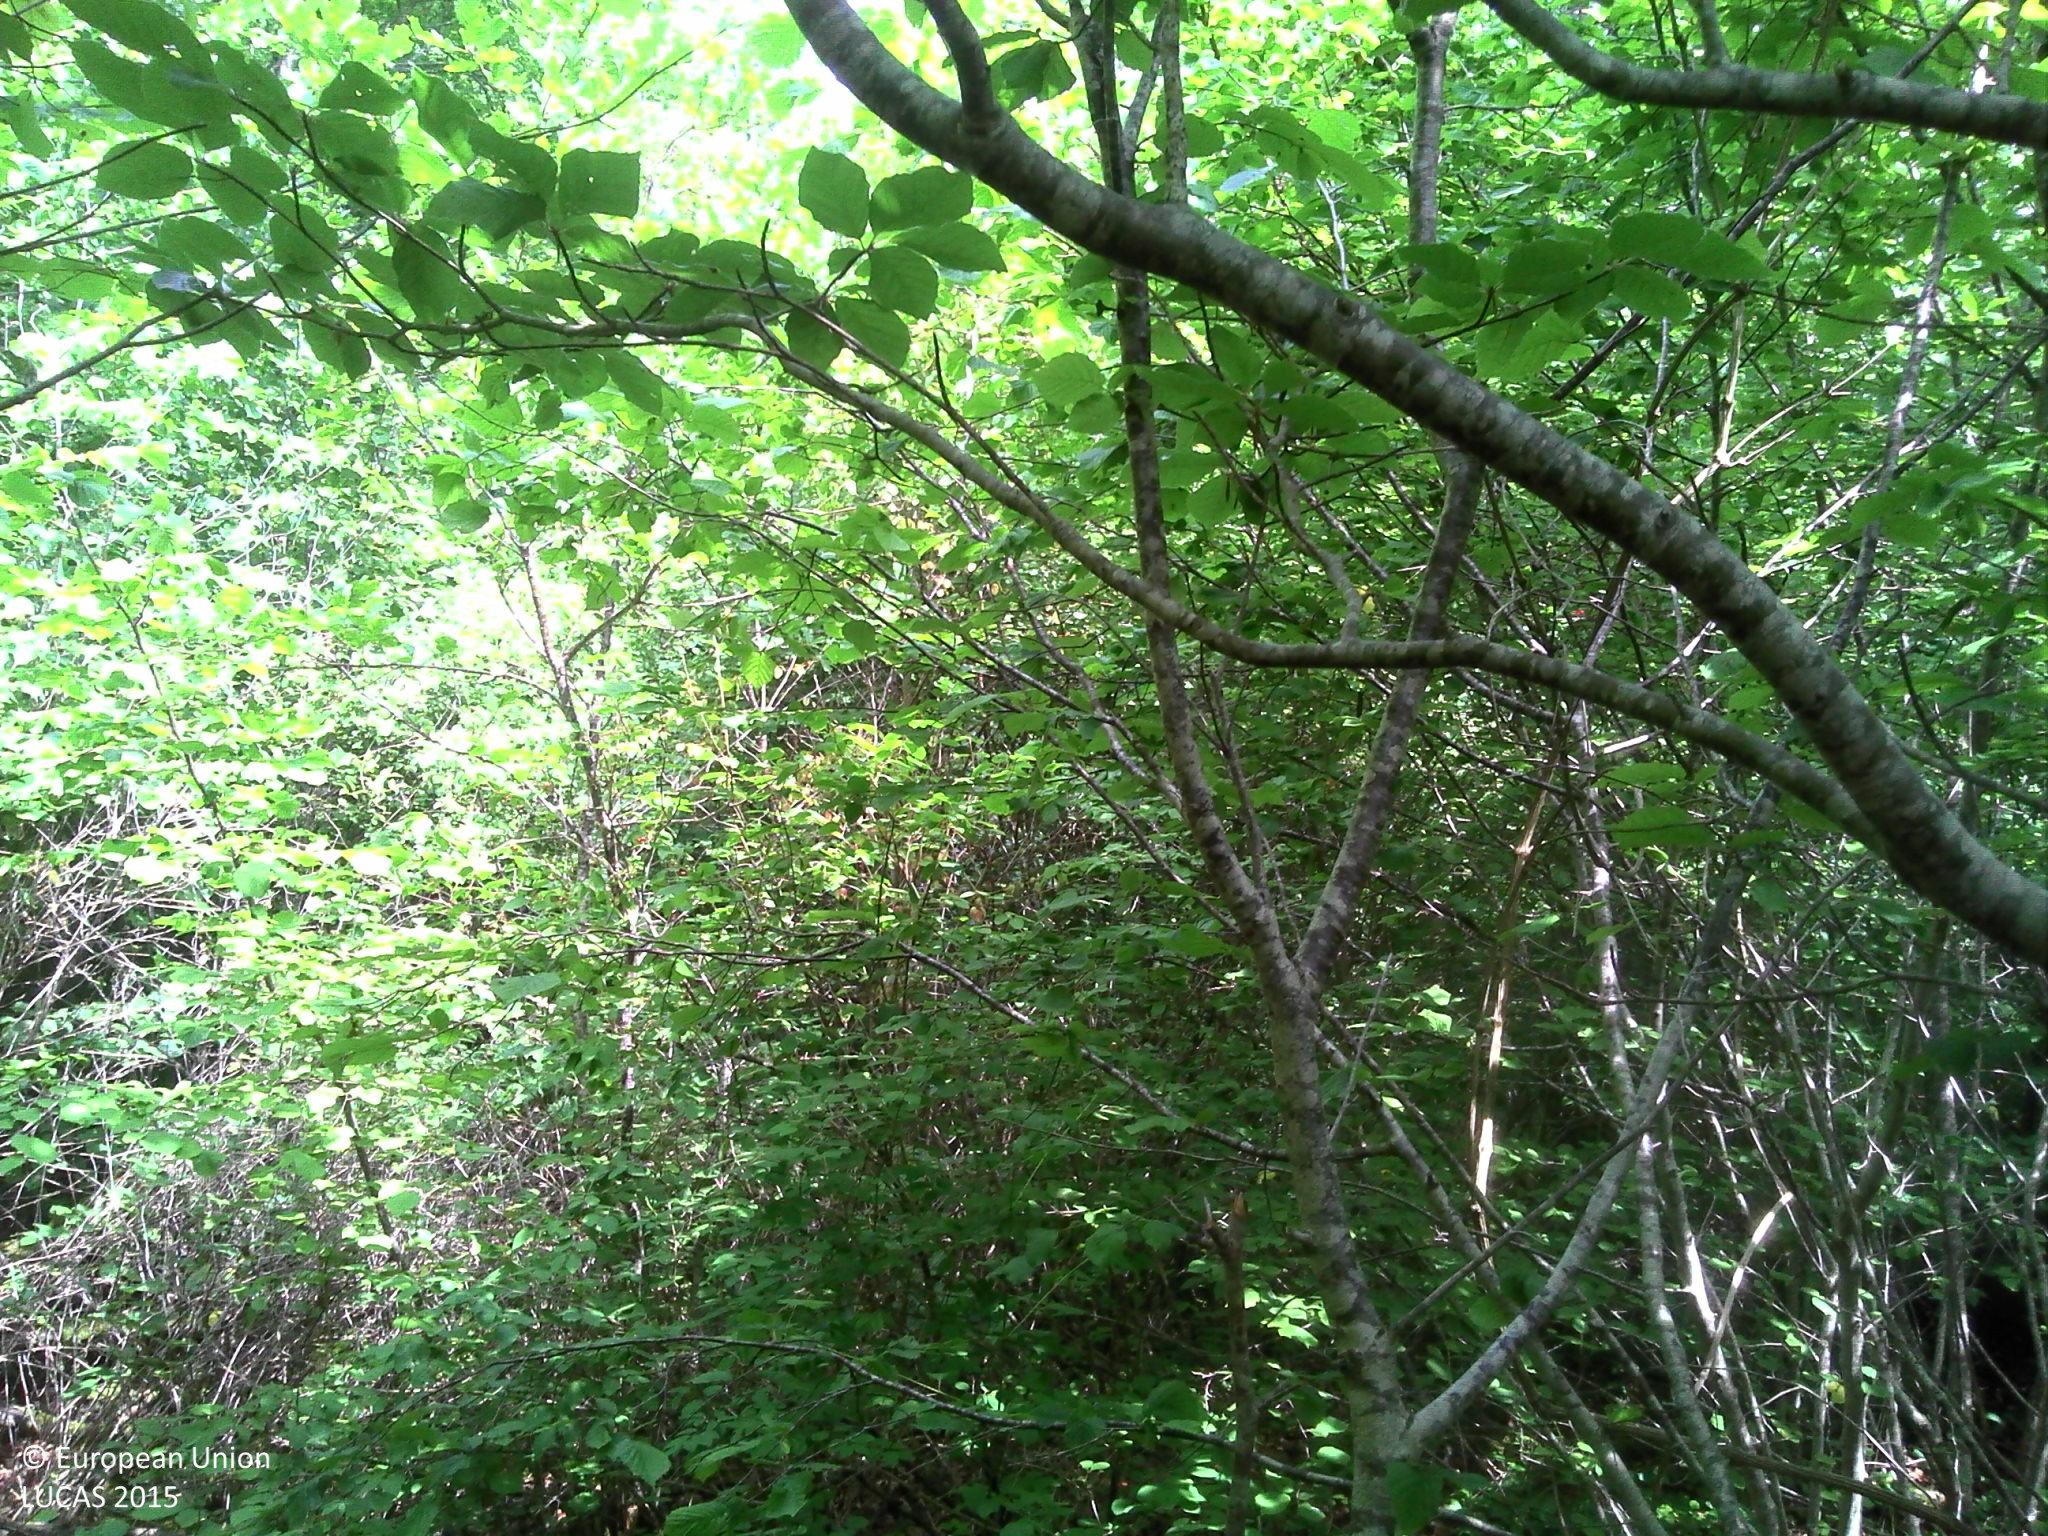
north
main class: Woodland
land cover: Broadleaved woodland
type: boreal forest
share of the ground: > 75 %
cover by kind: broadleaved forest trees 90 %, herbaceous plants 5 %, lichens and mosses 5 %
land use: Forestry
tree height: > 5 m
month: July
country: FR
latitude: 47.5963
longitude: 3.4658
